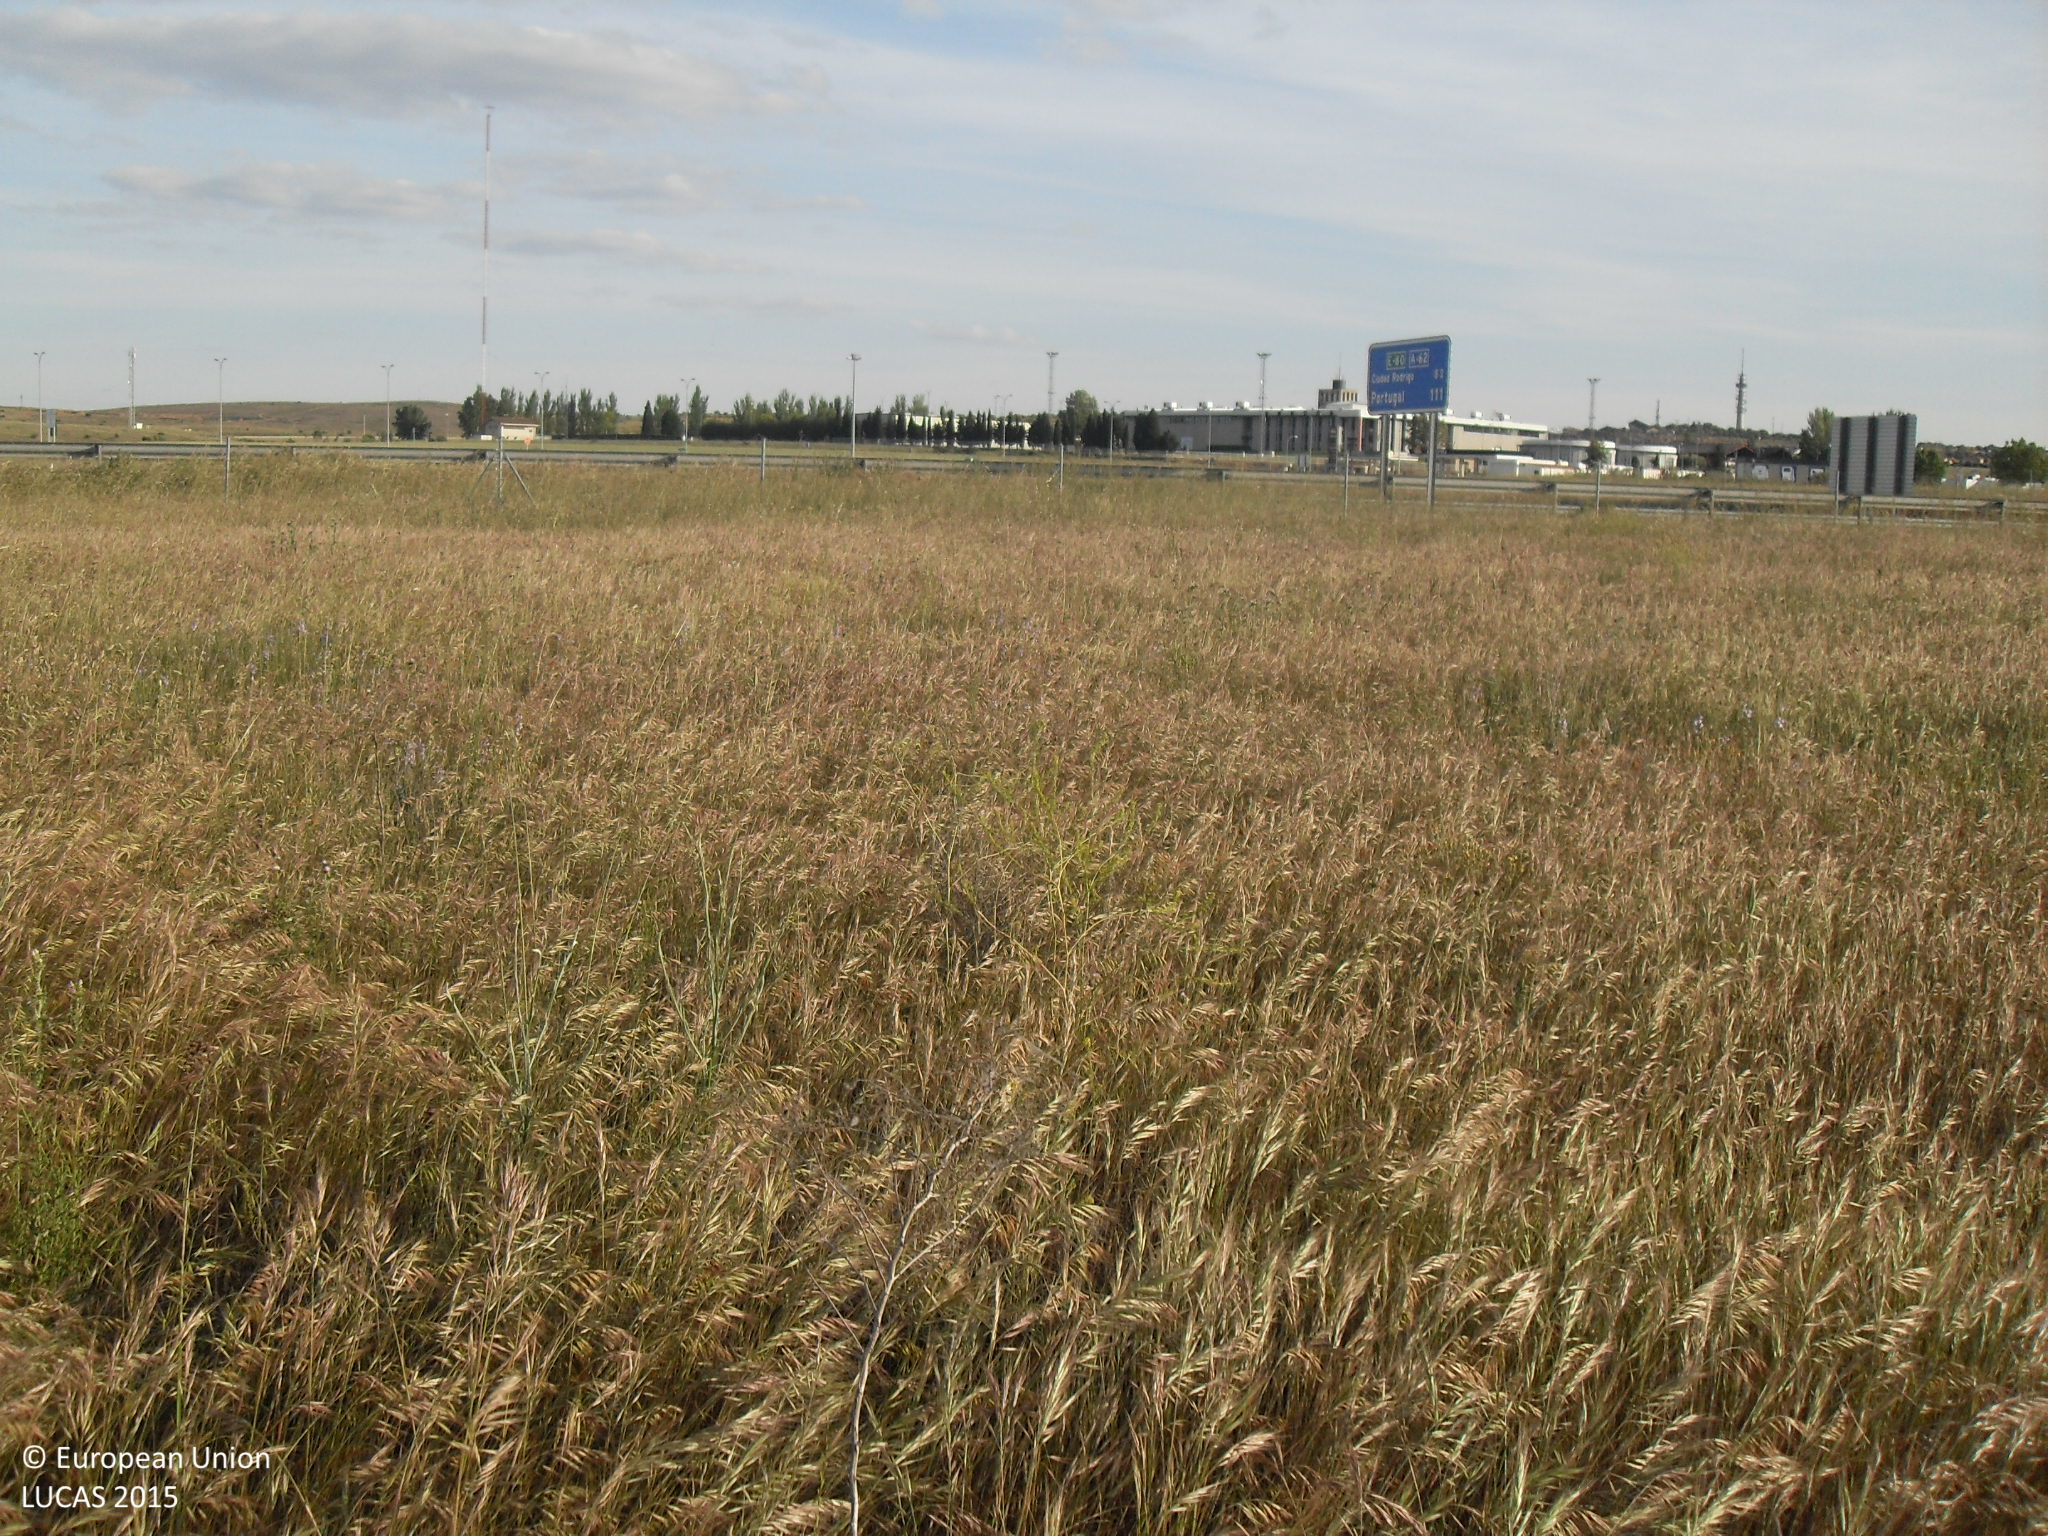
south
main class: Grassland
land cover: Grassland without tree/shrub cover
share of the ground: > 75 %
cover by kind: herbaceous plants 100 %
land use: Agriculture (excluding fallow land and kitchen gardens)
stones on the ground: 10 - 25 %
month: May
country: ES
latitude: 40.9574
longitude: -5.7254
